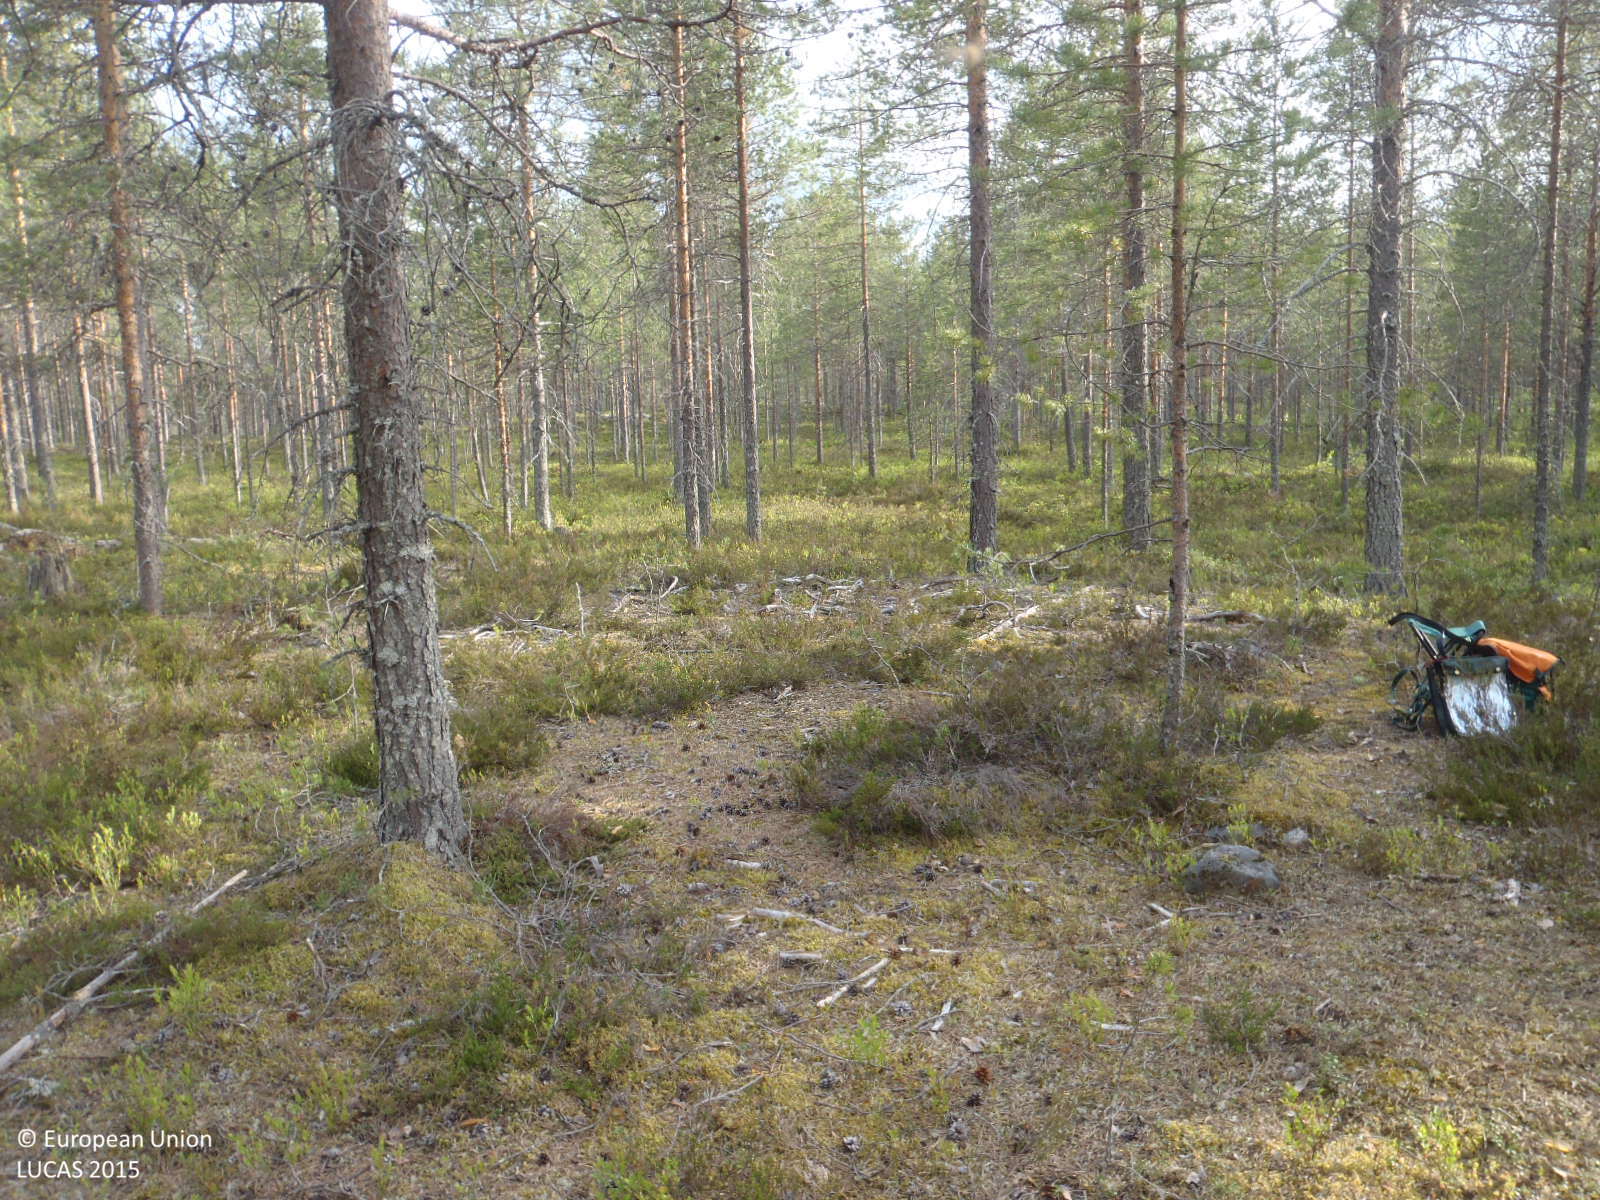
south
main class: Woodland
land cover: Pine dominated coniferous woodland
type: boreal forest
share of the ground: 50 - 75 %
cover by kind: coniferous forest trees 70 %, shrubs 25 %, lichens and mosses 5 %
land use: Forestry
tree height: > 5 m
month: June
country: FI
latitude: 65.2665
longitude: 26.8869
